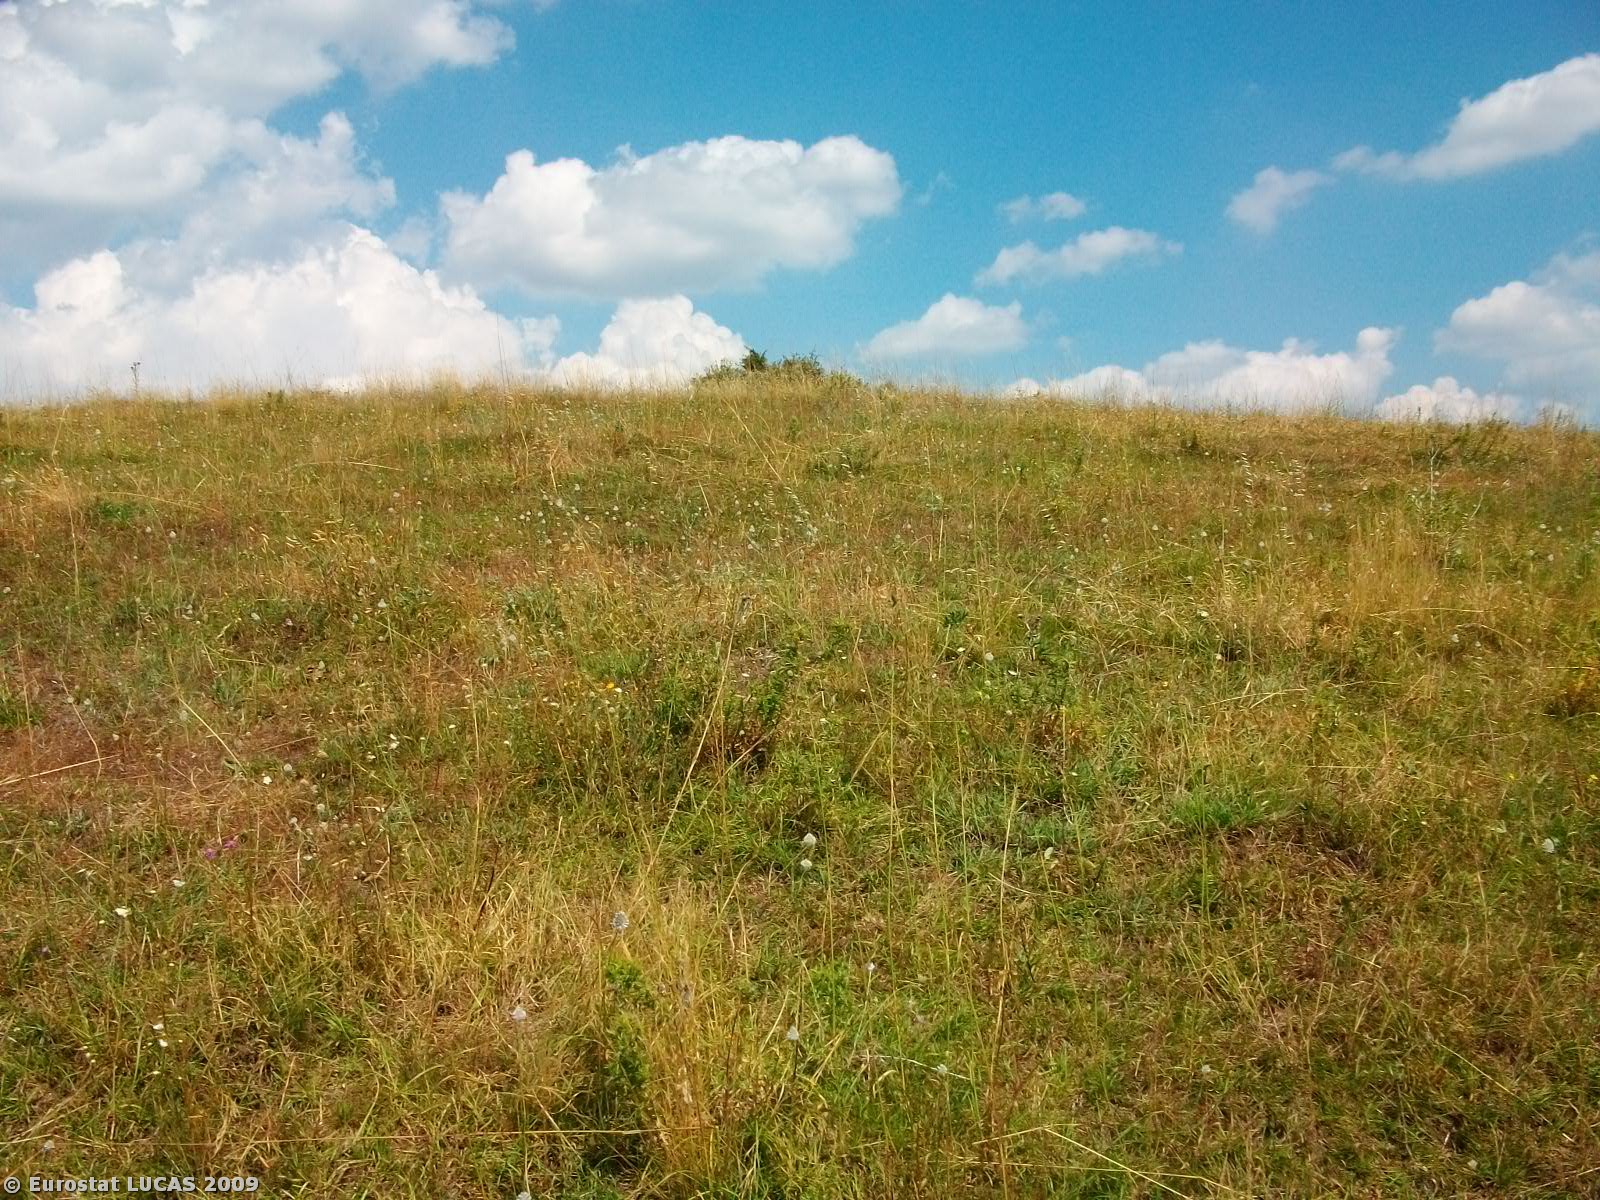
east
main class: Grassland
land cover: Grassland without tree/shrub cover
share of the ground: > 75 %
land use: Agriculture (excluding fallow land and kitchen gardens)
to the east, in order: Grassland without tree/shrub cover; Grassland with sparse tree/shrub cover; Shrubland with sparse tree cover; Shrubland without tree cover; Grassland with sparse tree/shrub cover
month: July
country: GR
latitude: 40.9120
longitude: 23.0358
